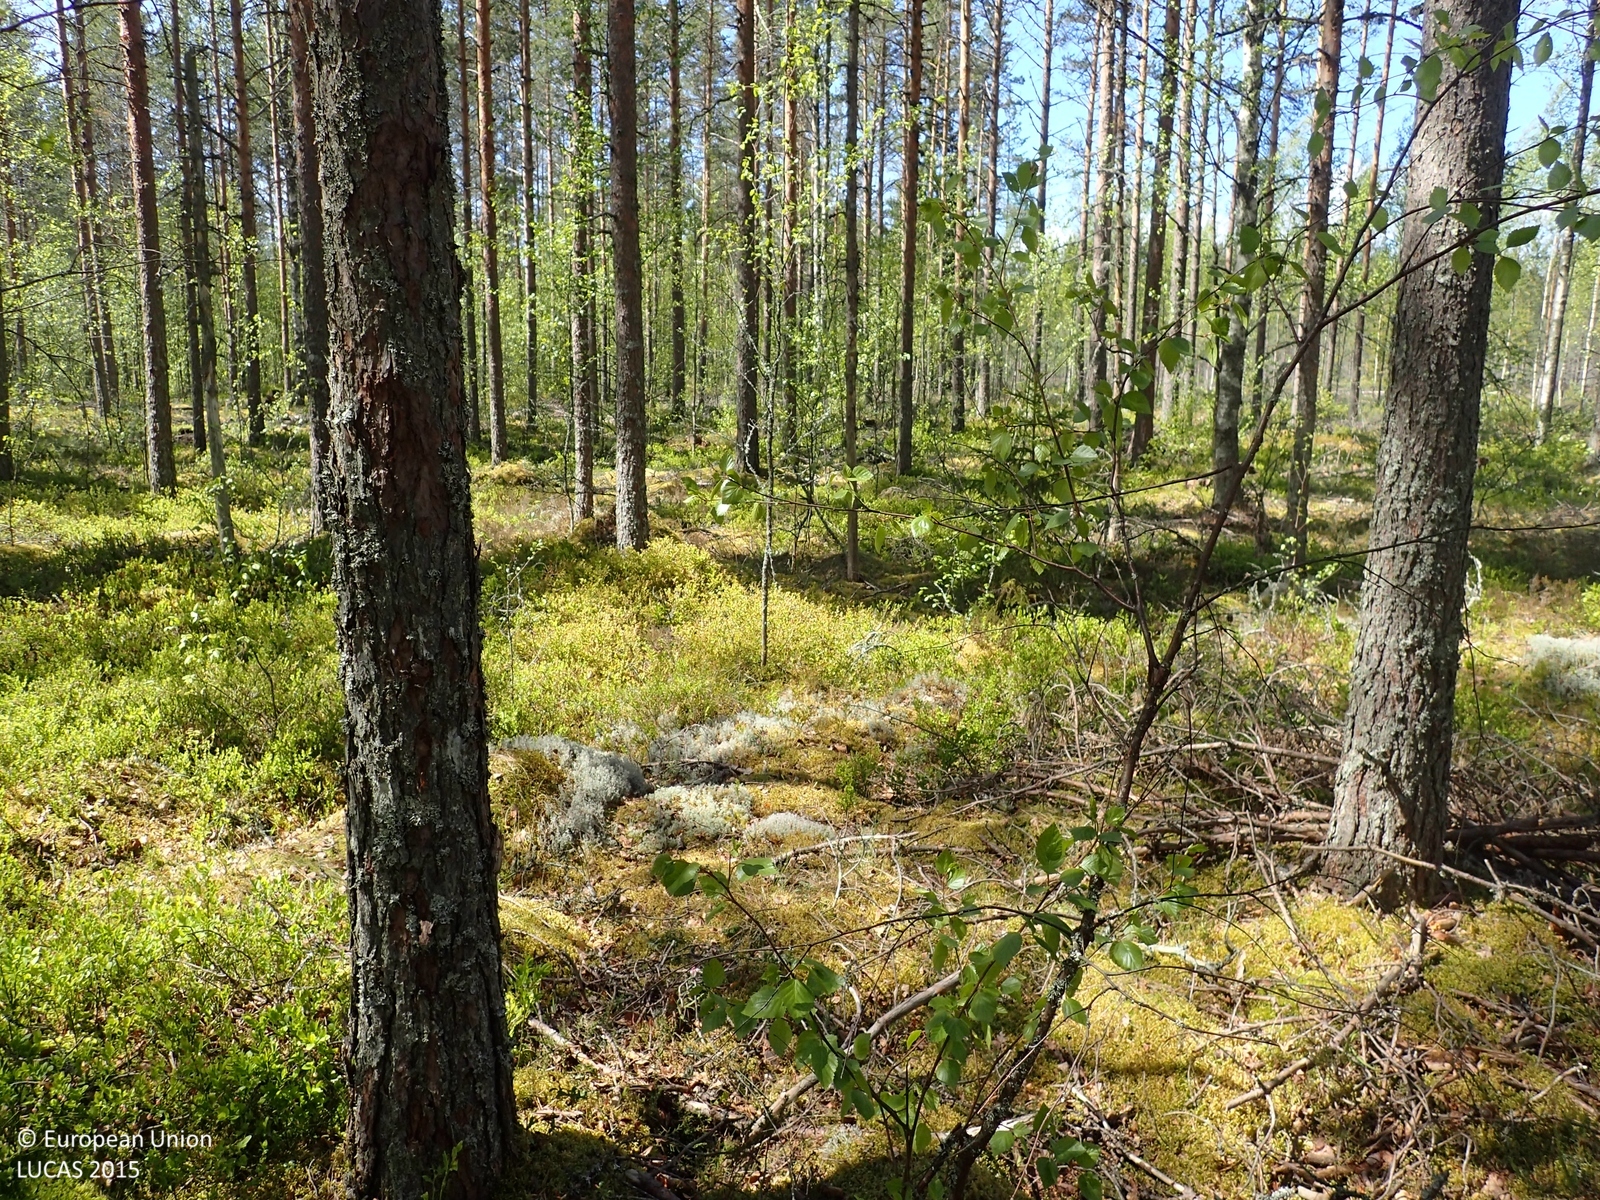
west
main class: Woodland
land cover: Pine dominated coniferous woodland
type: boreal forest
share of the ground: > 75 %
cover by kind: coniferous forest trees 60 %, broadleaved forest trees 20 %, shrubs 15 %, lichens and mosses 5 %
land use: Forestry
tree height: > 5 m
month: June
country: FI
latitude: 62.2184
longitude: 22.2668
